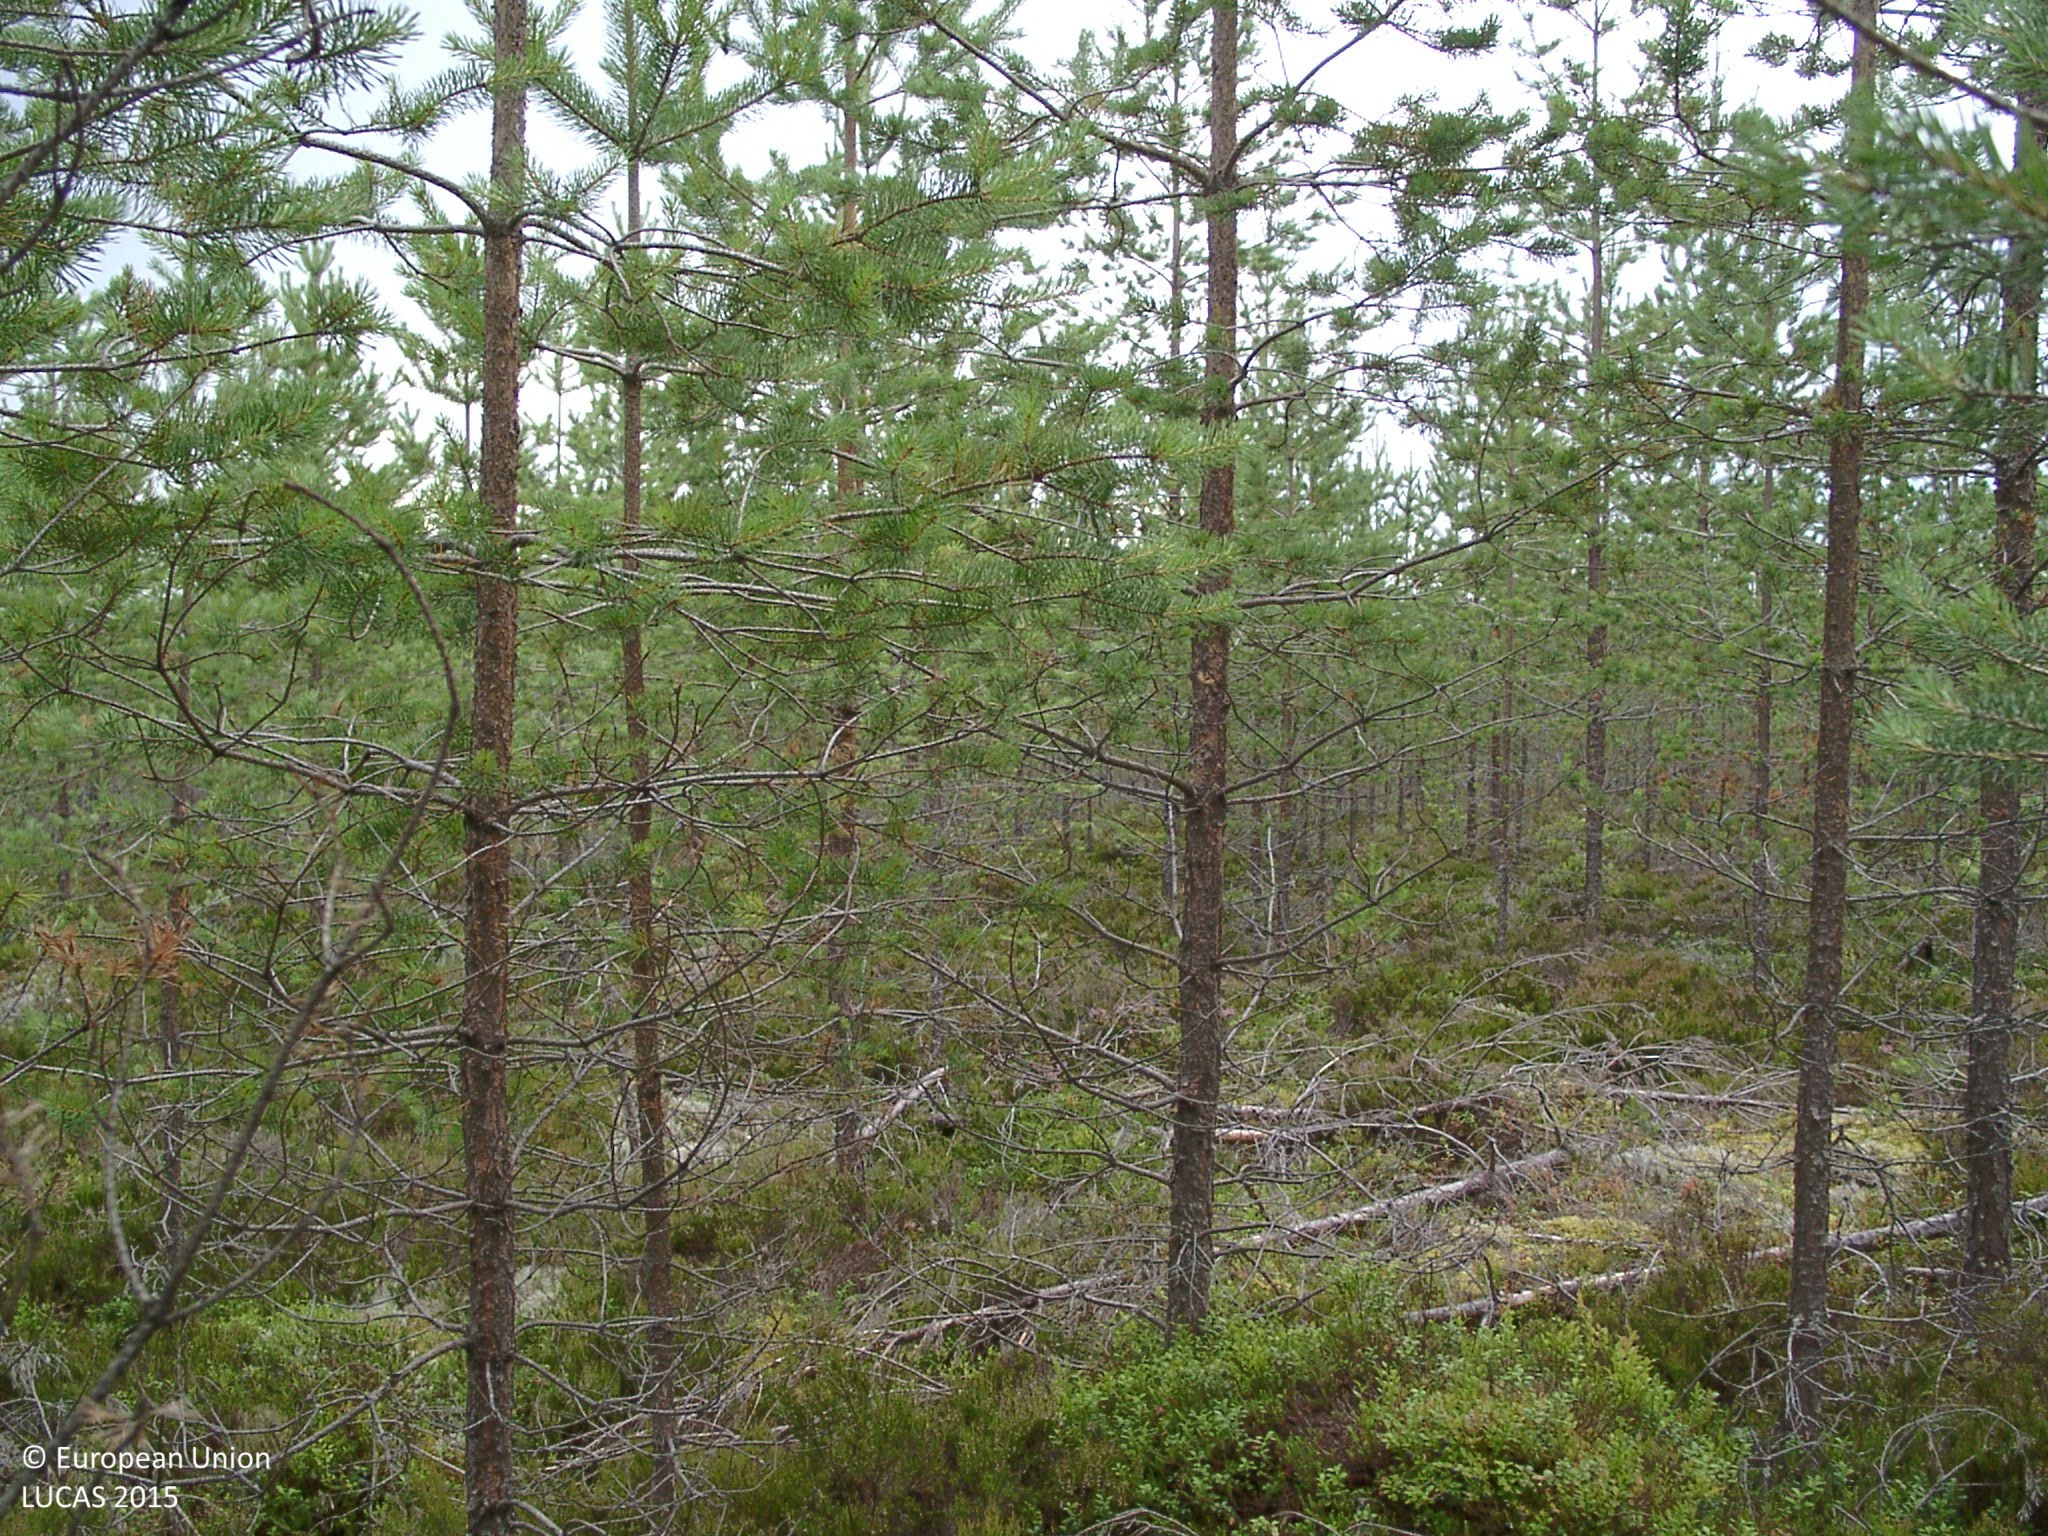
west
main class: Woodland
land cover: Pine dominated coniferous woodland
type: boreal forest
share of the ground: 50 - 75 %
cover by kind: coniferous forest trees 50 %, shrubs 35 %, lichens and mosses 15 %
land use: Forestry
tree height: < 5 m
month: July
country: FI
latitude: 62.7249
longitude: 24.5832
